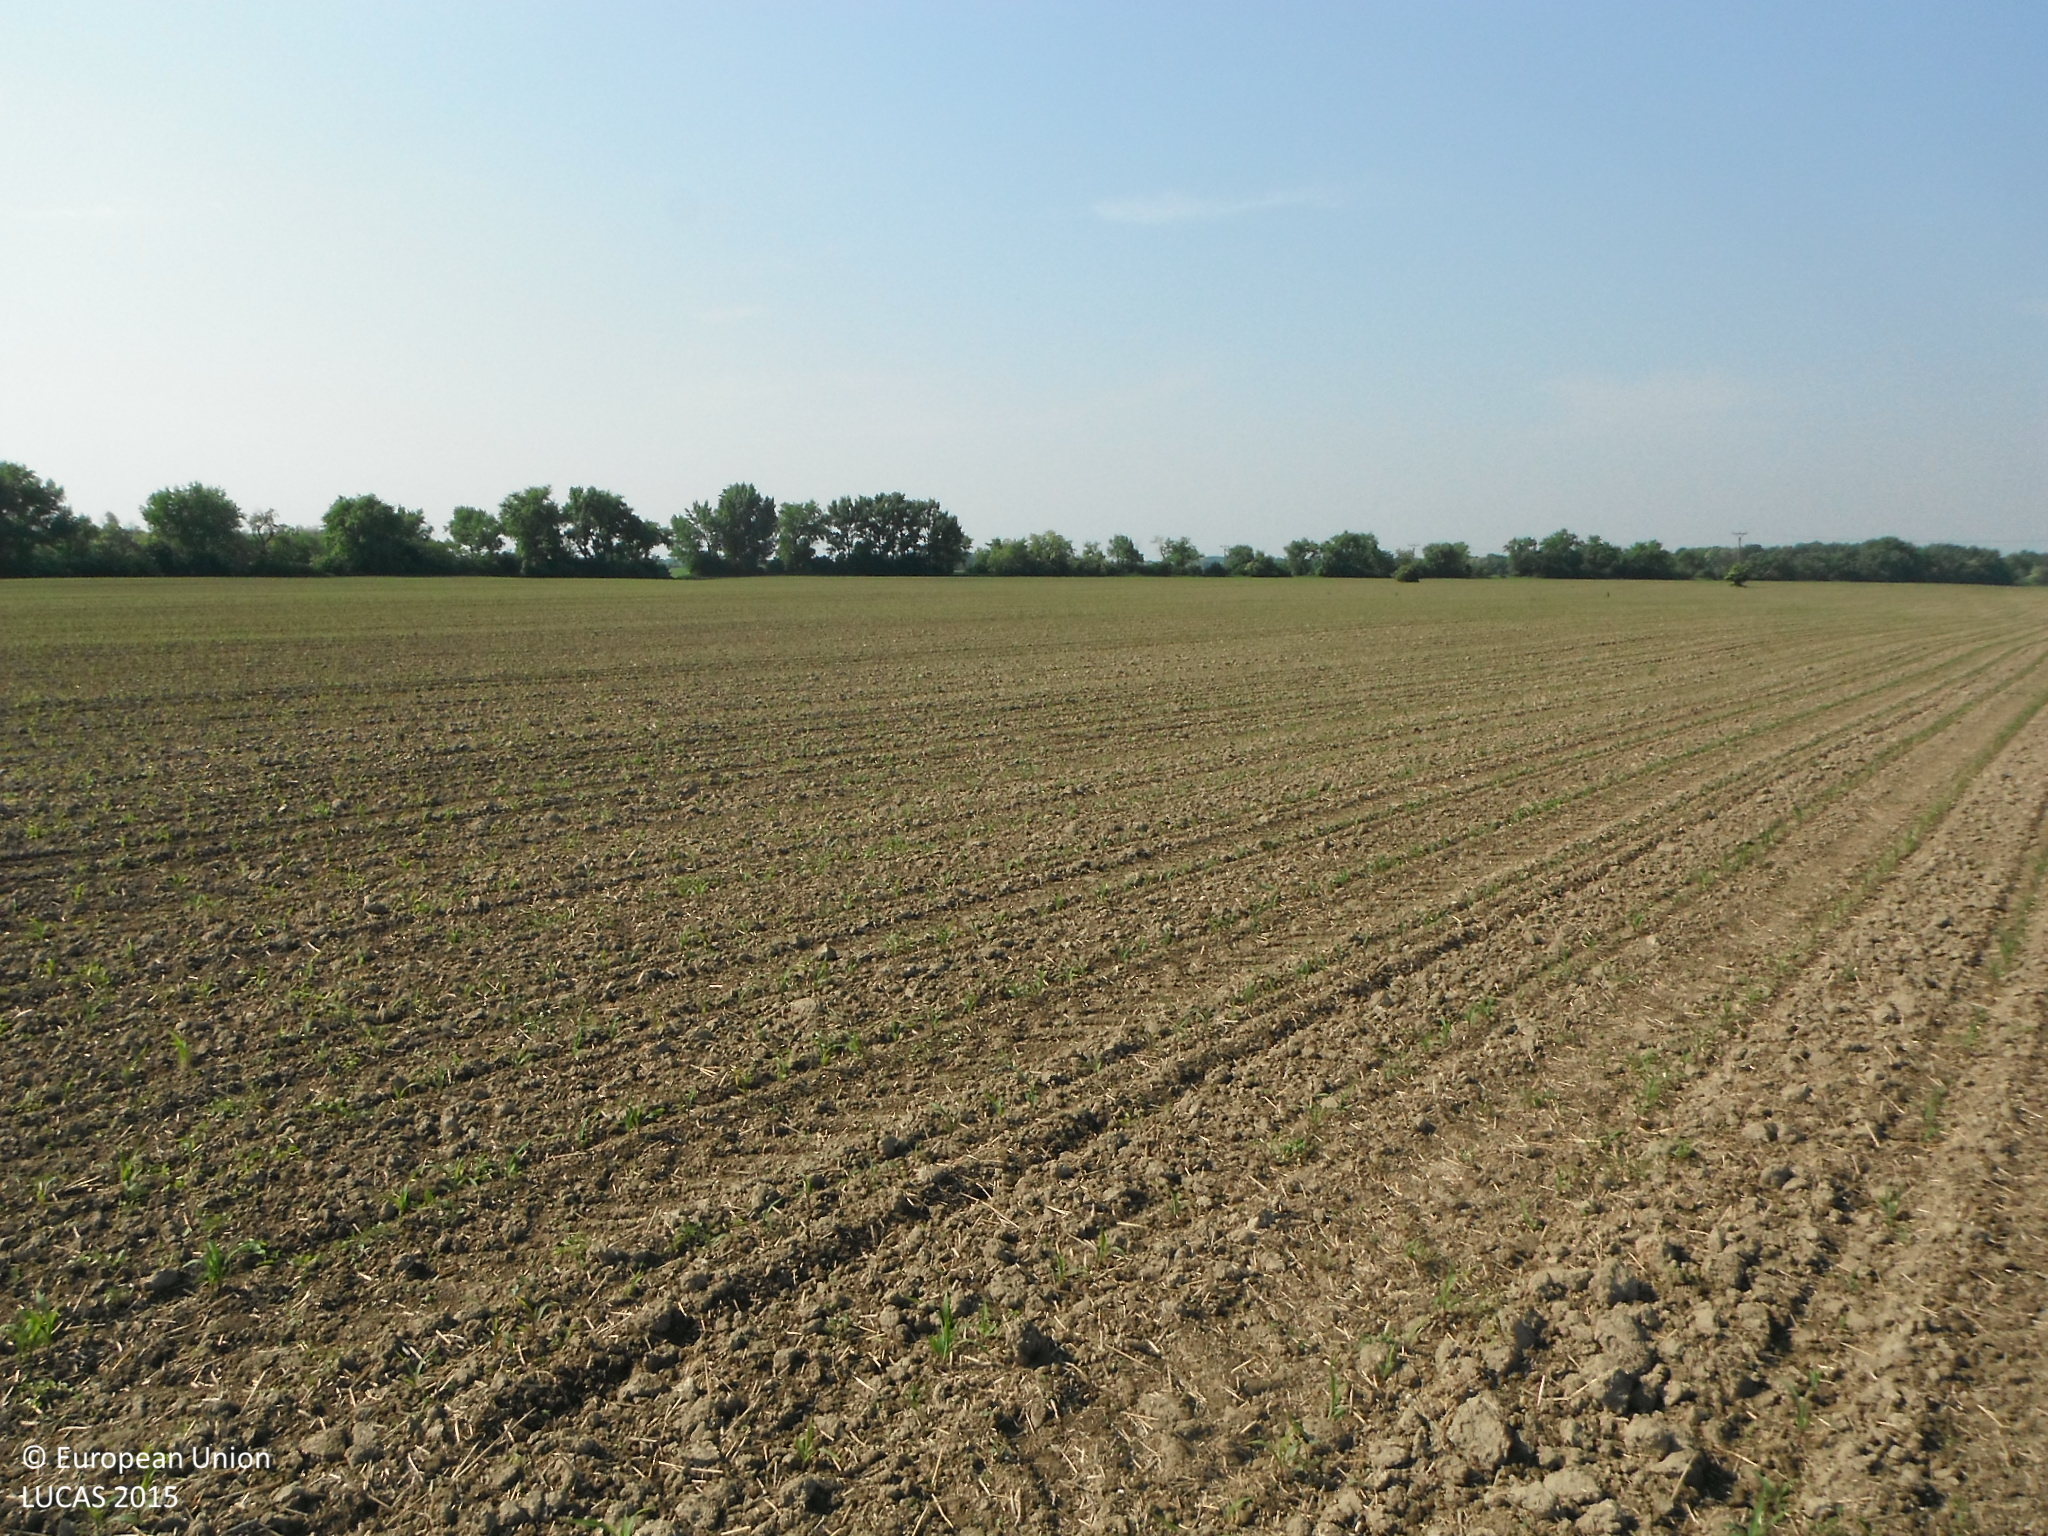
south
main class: Cropland
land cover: Maize
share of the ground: < 10 %
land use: Agriculture (excluding fallow land and kitchen gardens)
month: May
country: SK
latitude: 48.0951
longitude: 17.2187
